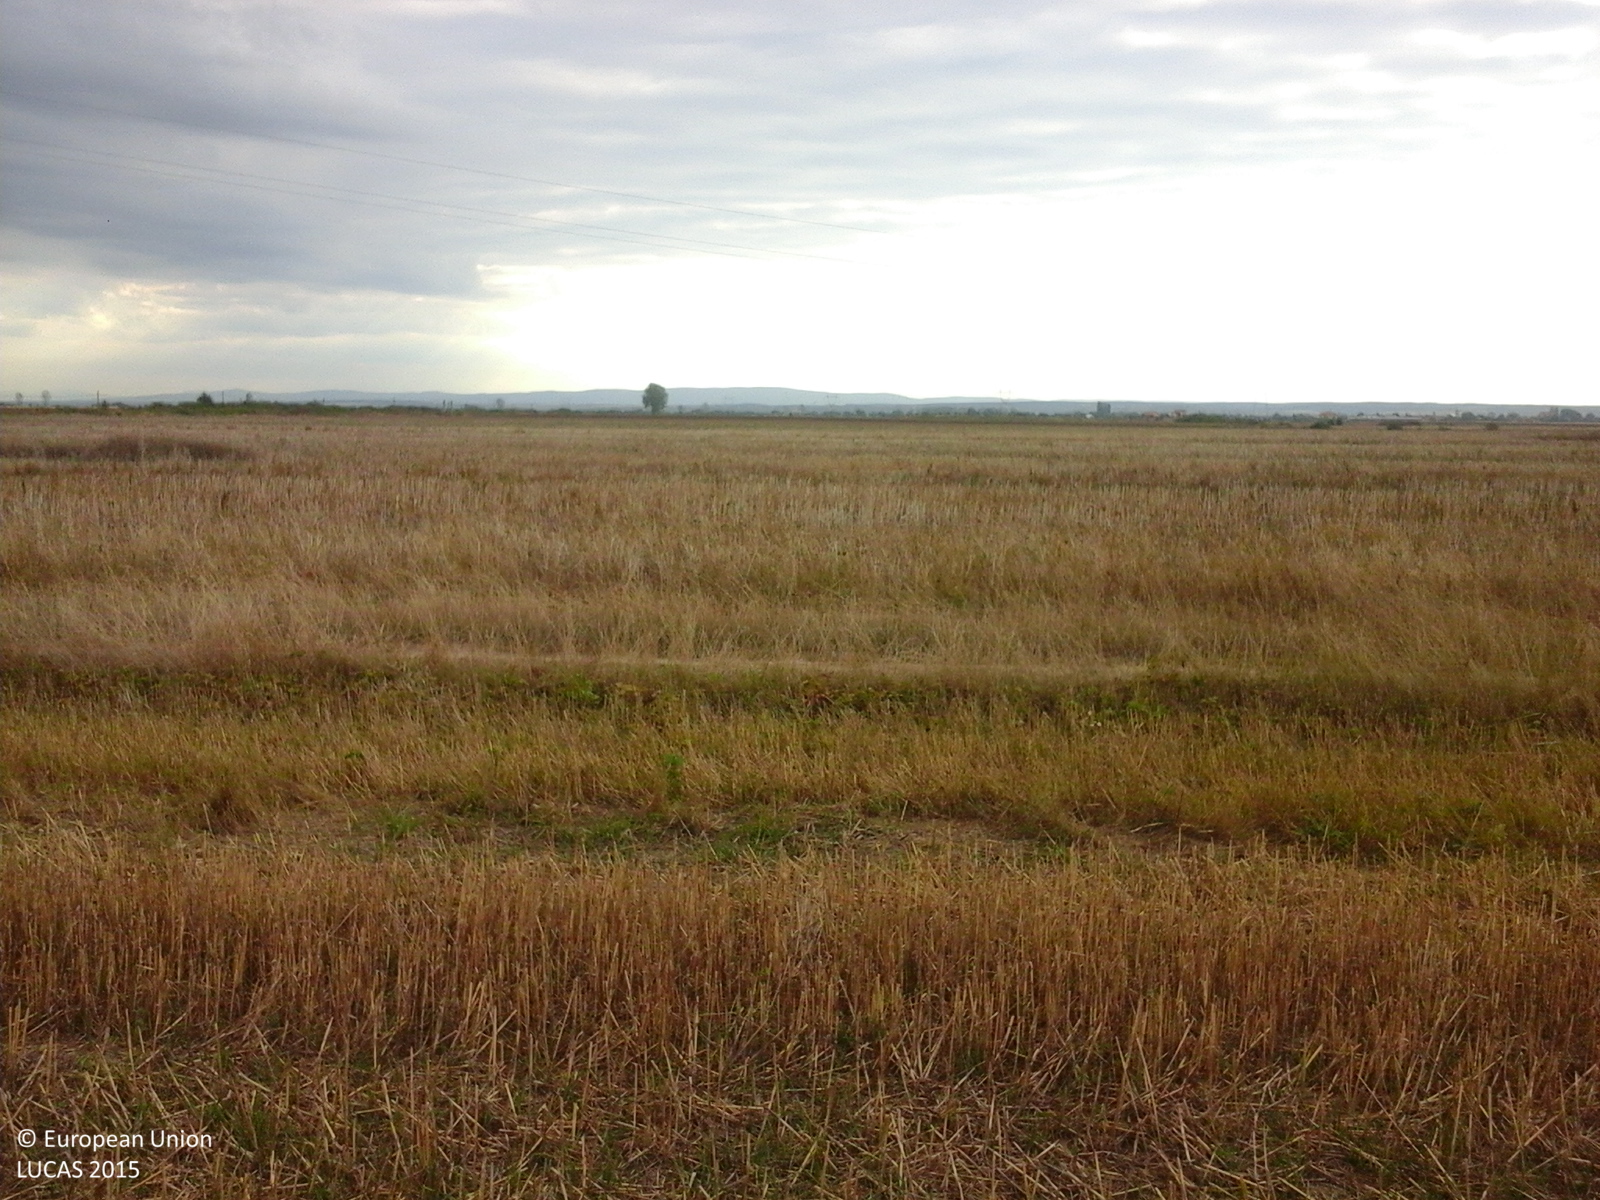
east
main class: Cropland
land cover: Common wheat
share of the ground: > 75 %
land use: Agriculture (excluding fallow land and kitchen gardens)
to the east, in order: Common wheat; Grass margins; Tracks; Grass margins; Rape and turnip rape; Electric lines; Rape and turnip rape; Other bare soil
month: September
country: RO
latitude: 47.5523
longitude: 22.7516
